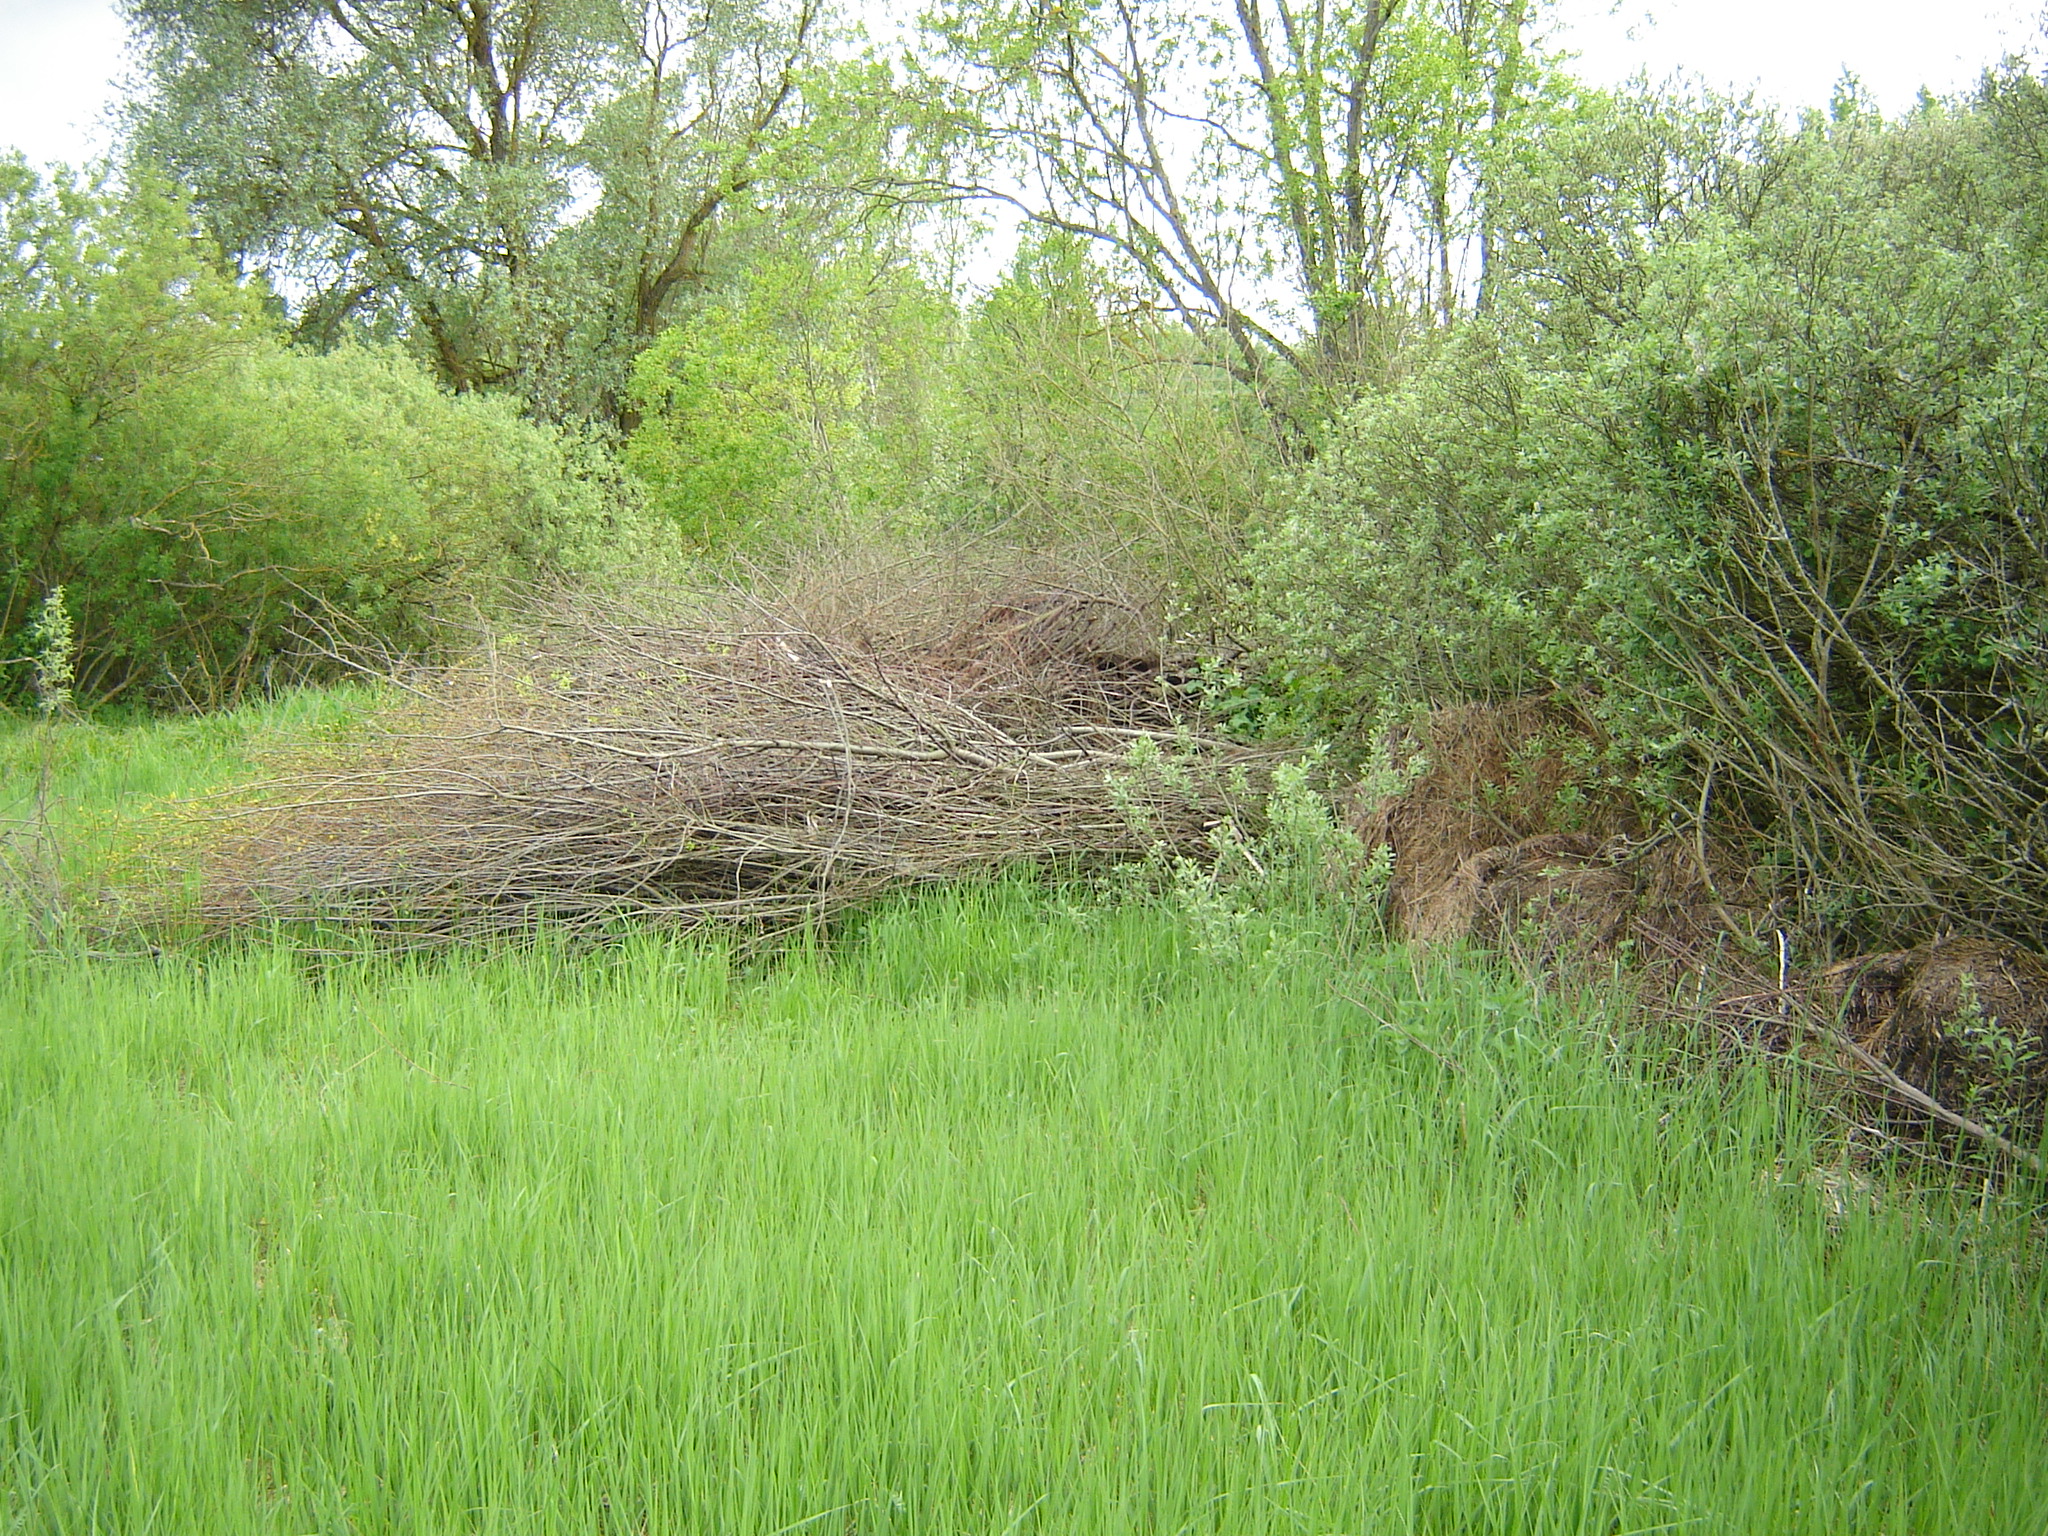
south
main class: Grassland
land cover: Grassland with sparse tree/shrub cover
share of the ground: > 75 %
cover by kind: herbaceous plants 95 %, broadleaved forest trees 5 %
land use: Semi-natural and natural areas not in use
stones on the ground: < 10 %
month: May
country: LT
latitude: 55.9980
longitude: 25.4331
